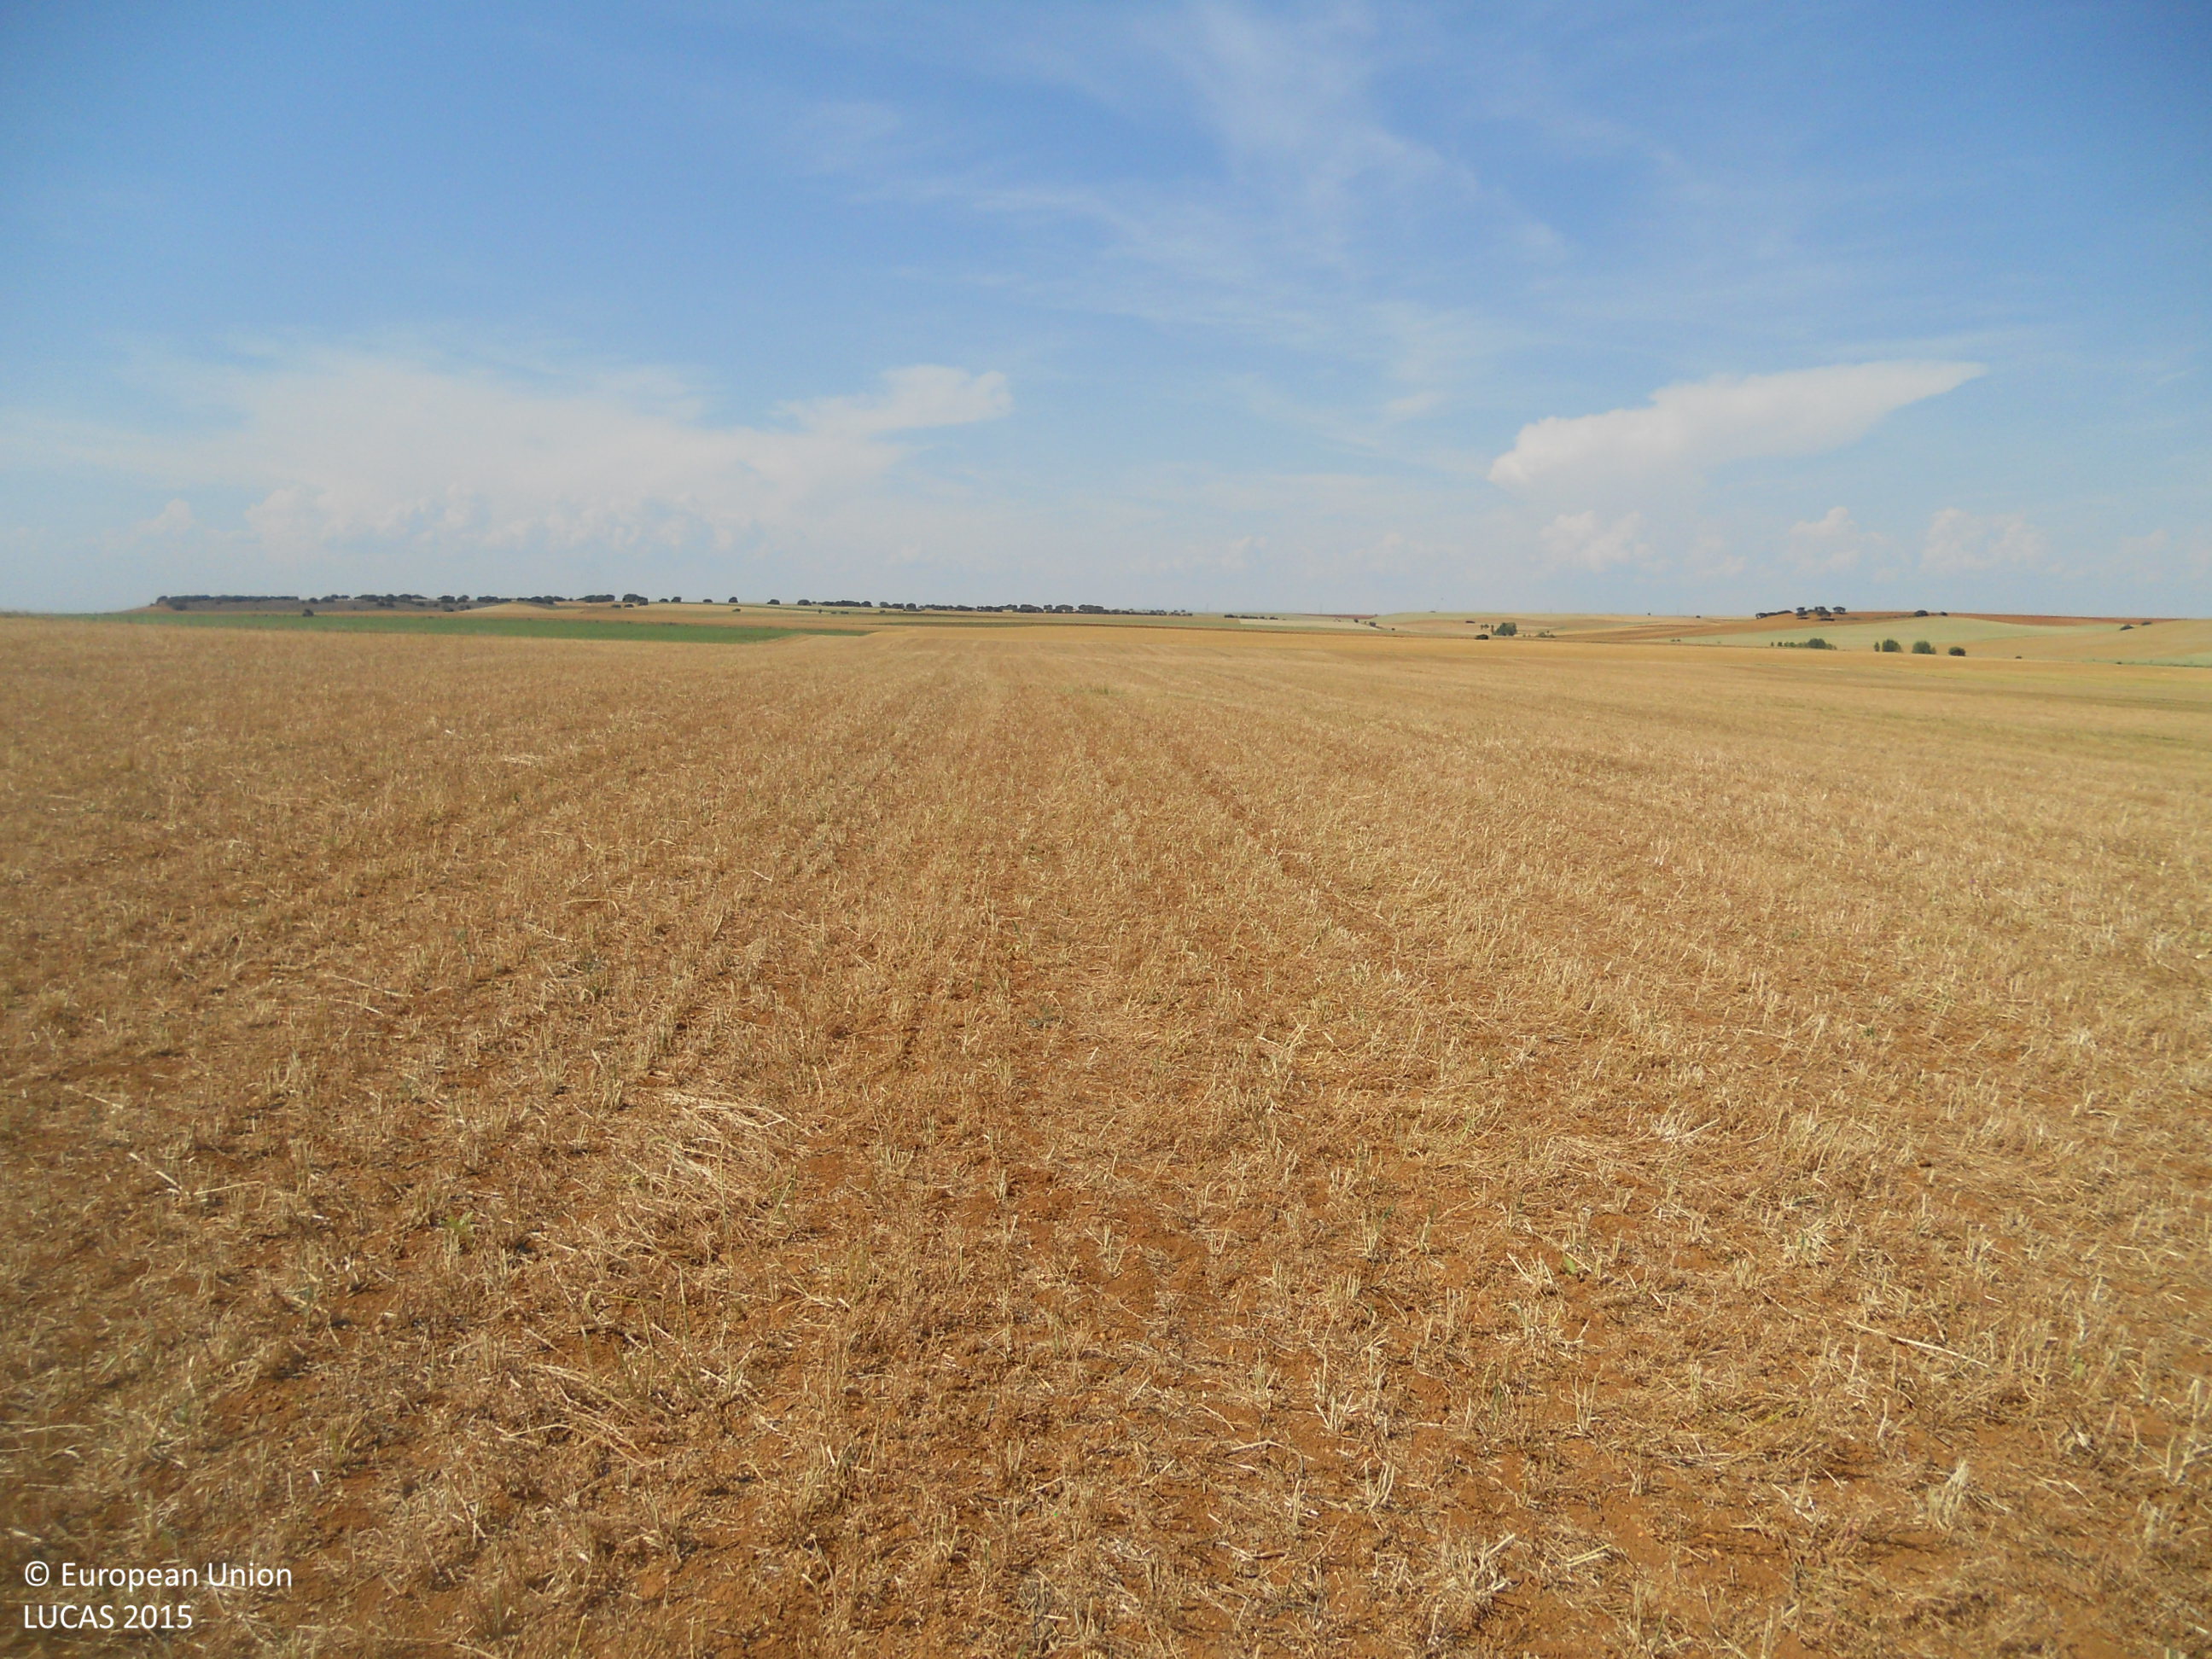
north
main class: Cropland
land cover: Mixed cereals for fodder
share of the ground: < 10 %
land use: Agriculture (excluding fallow land and kitchen gardens)
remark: Harvested field
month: June
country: ES
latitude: 42.1897
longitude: -5.4805
